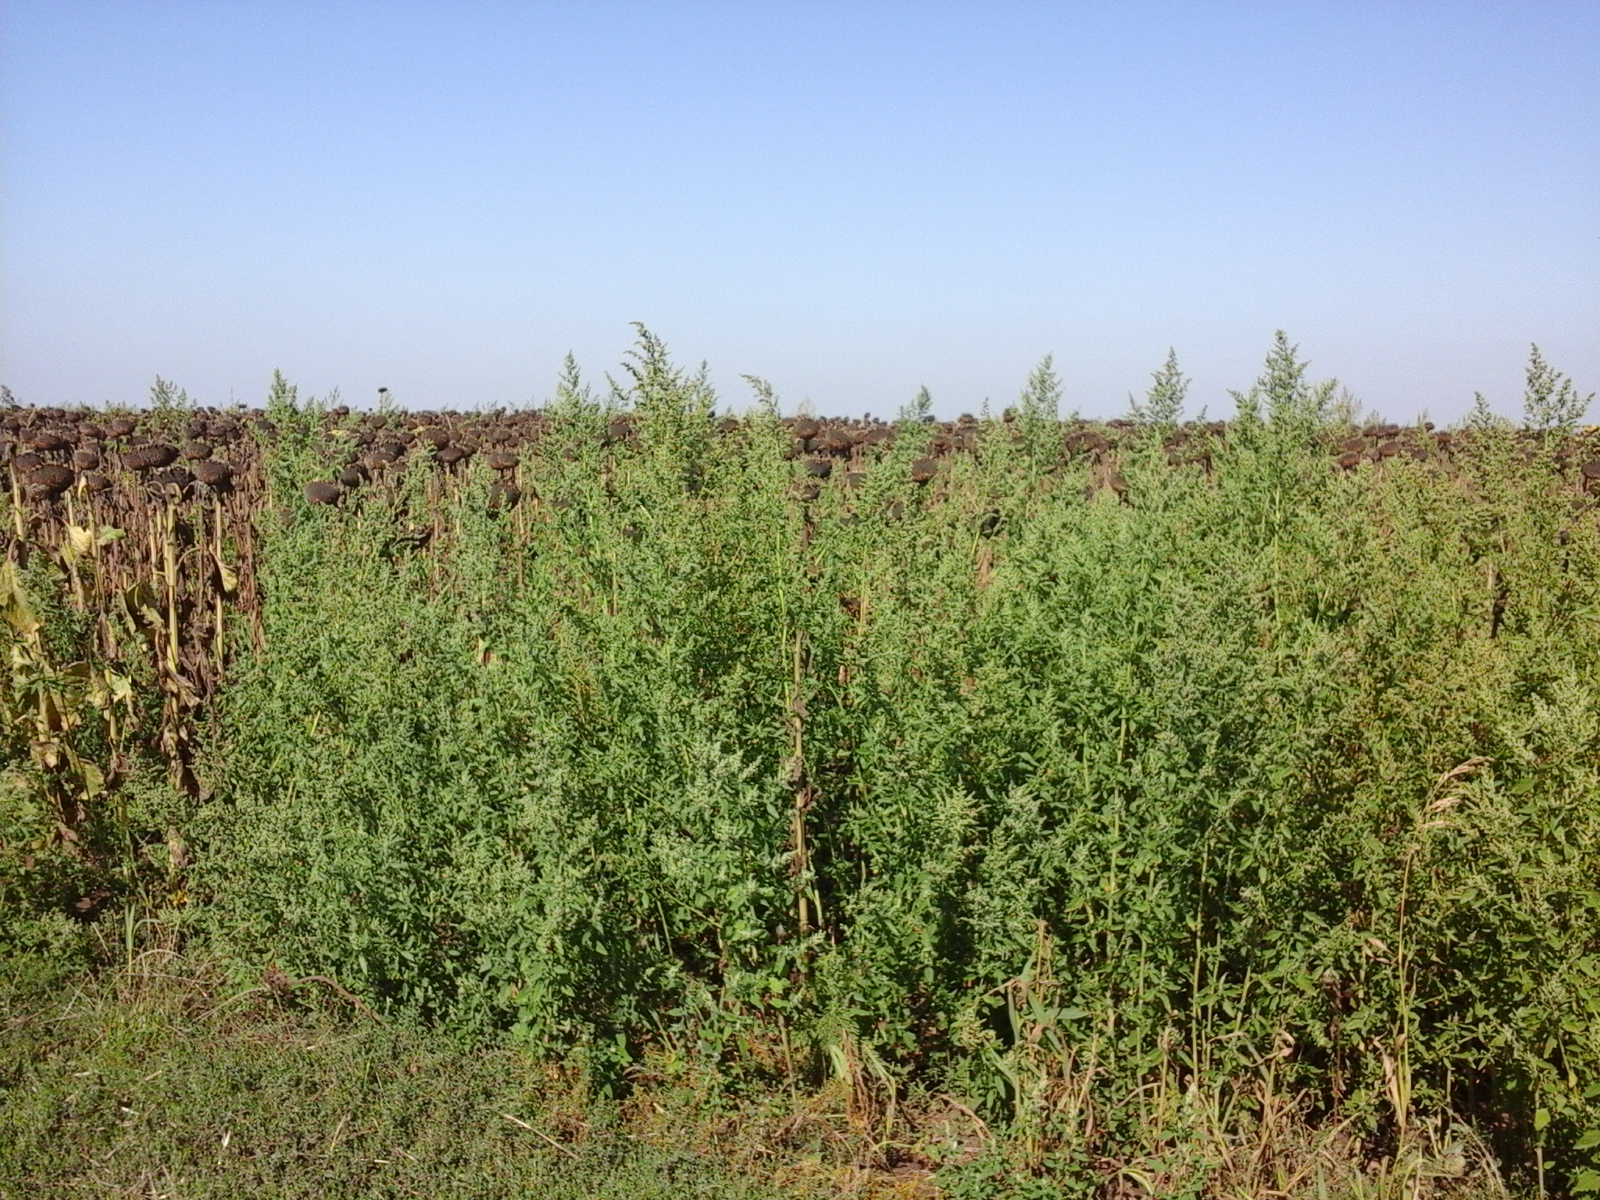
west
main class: Cropland
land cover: Sunflower
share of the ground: > 75 %
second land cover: Spontaneously vegetated surfaces
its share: 50 - 75 %
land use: Agriculture (excluding fallow land and kitchen gardens)
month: August
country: RO
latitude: 45.9013
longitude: 21.0760
